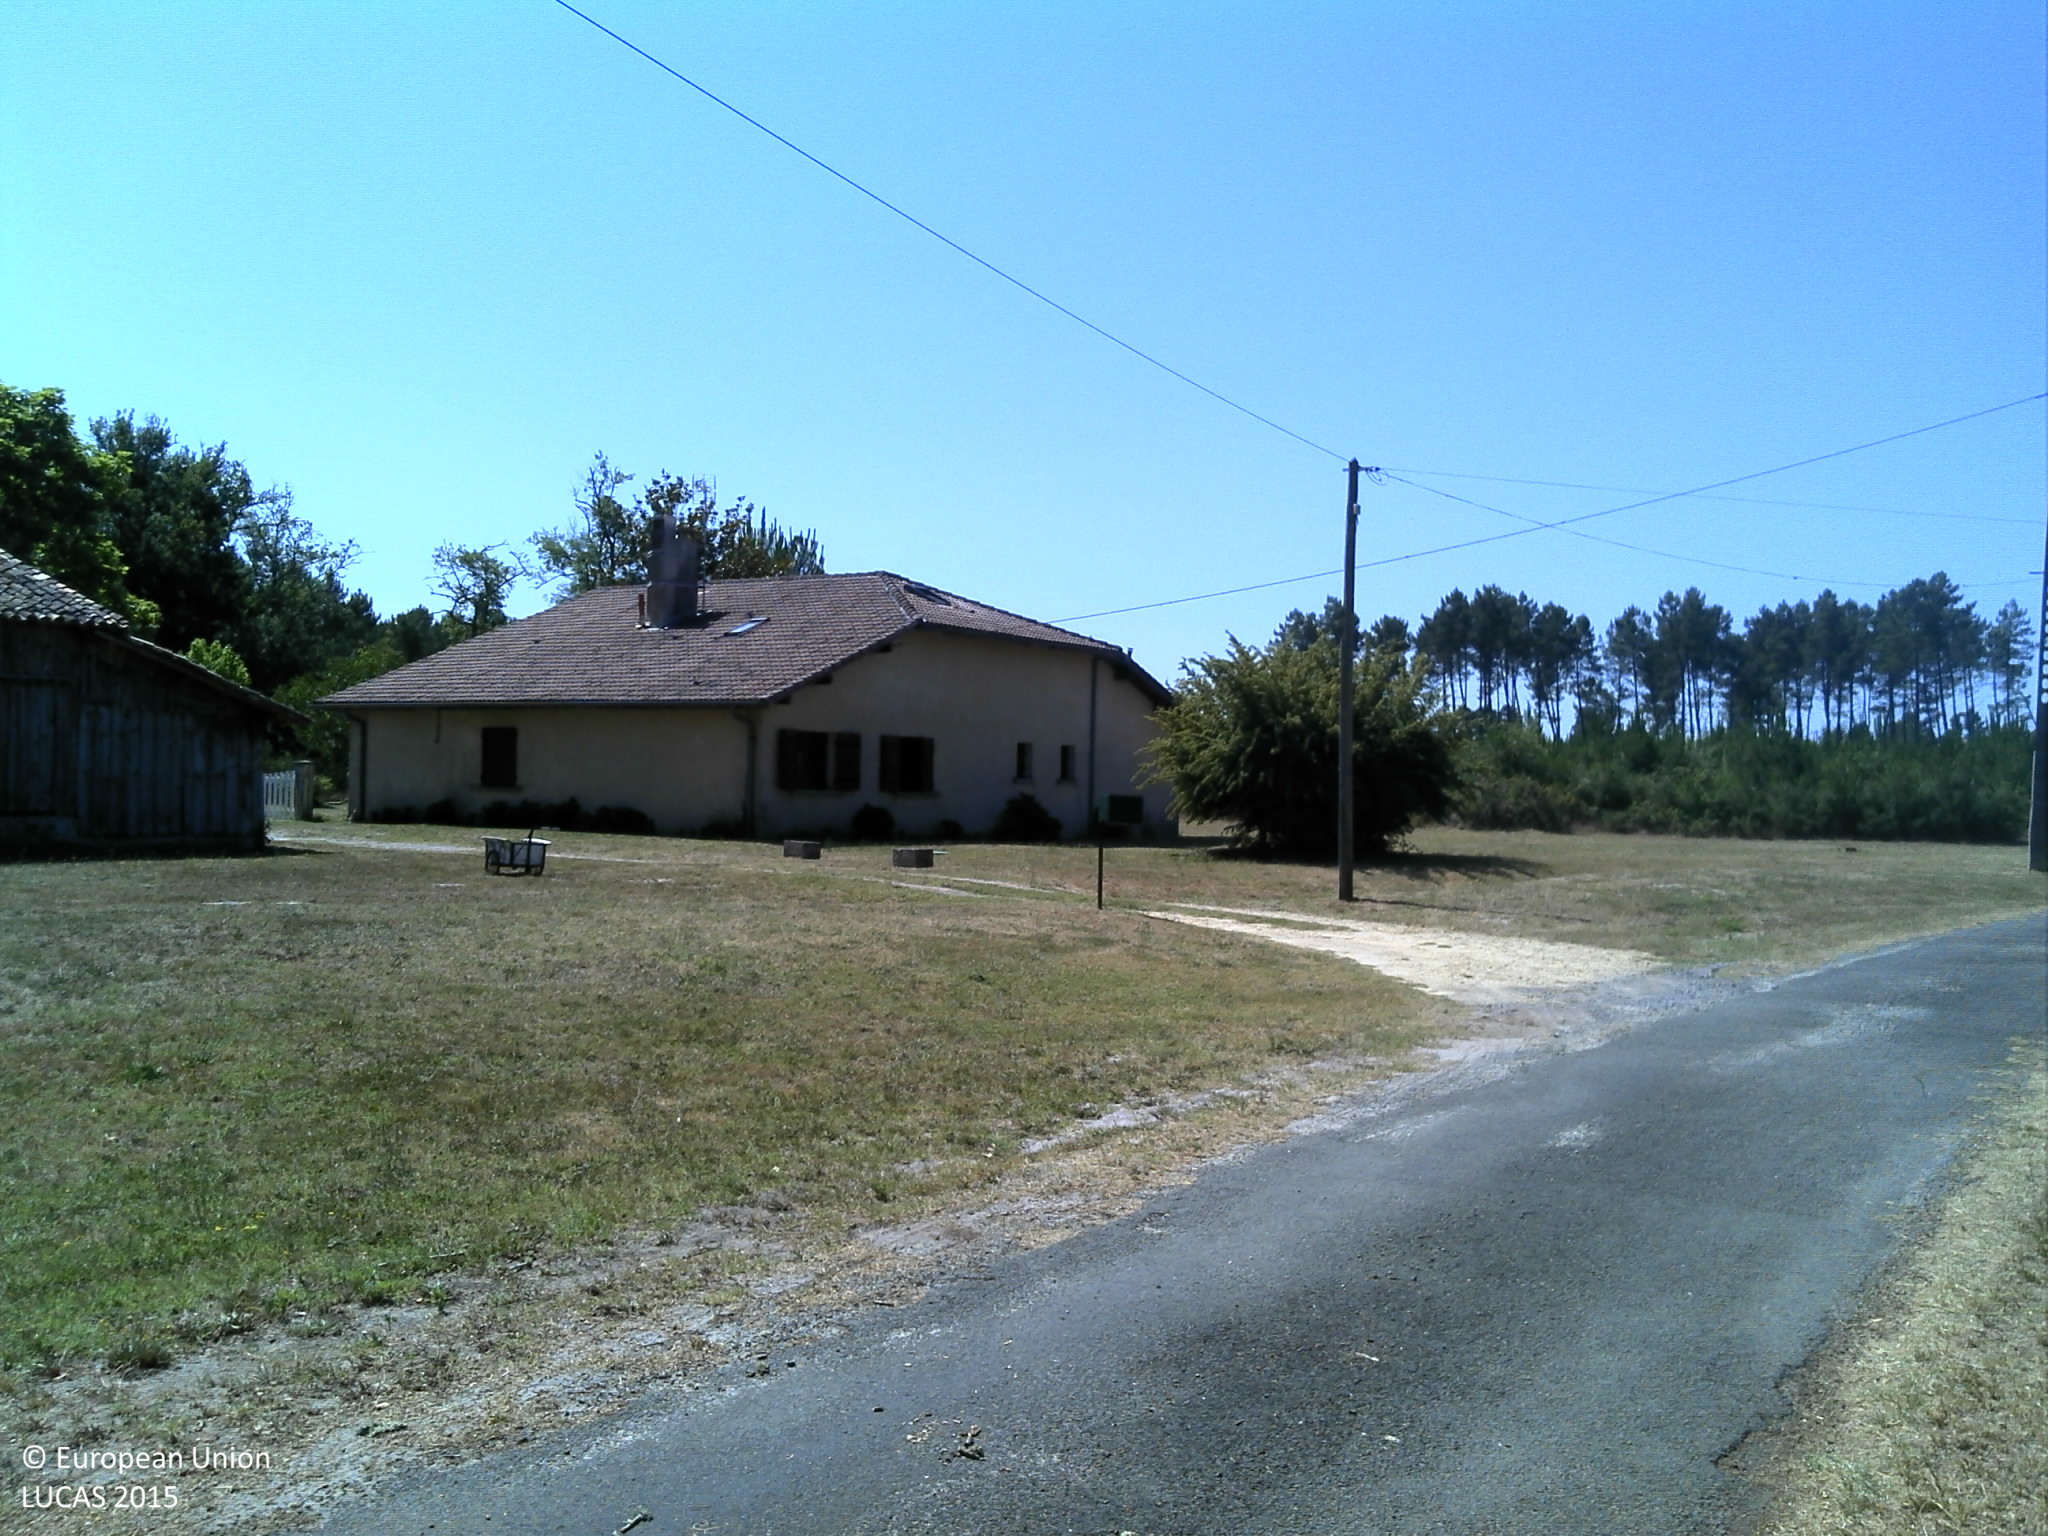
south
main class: Grassland
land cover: Grassland with sparse tree/shrub cover
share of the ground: > 75 %
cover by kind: herbaceous plants 85 %, broadleaved forest trees 5 %, shrubs 5 %, lichens and mosses 5 %
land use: Residential
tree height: < 5 m
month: July
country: FR
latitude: 44.3775
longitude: -0.3429
